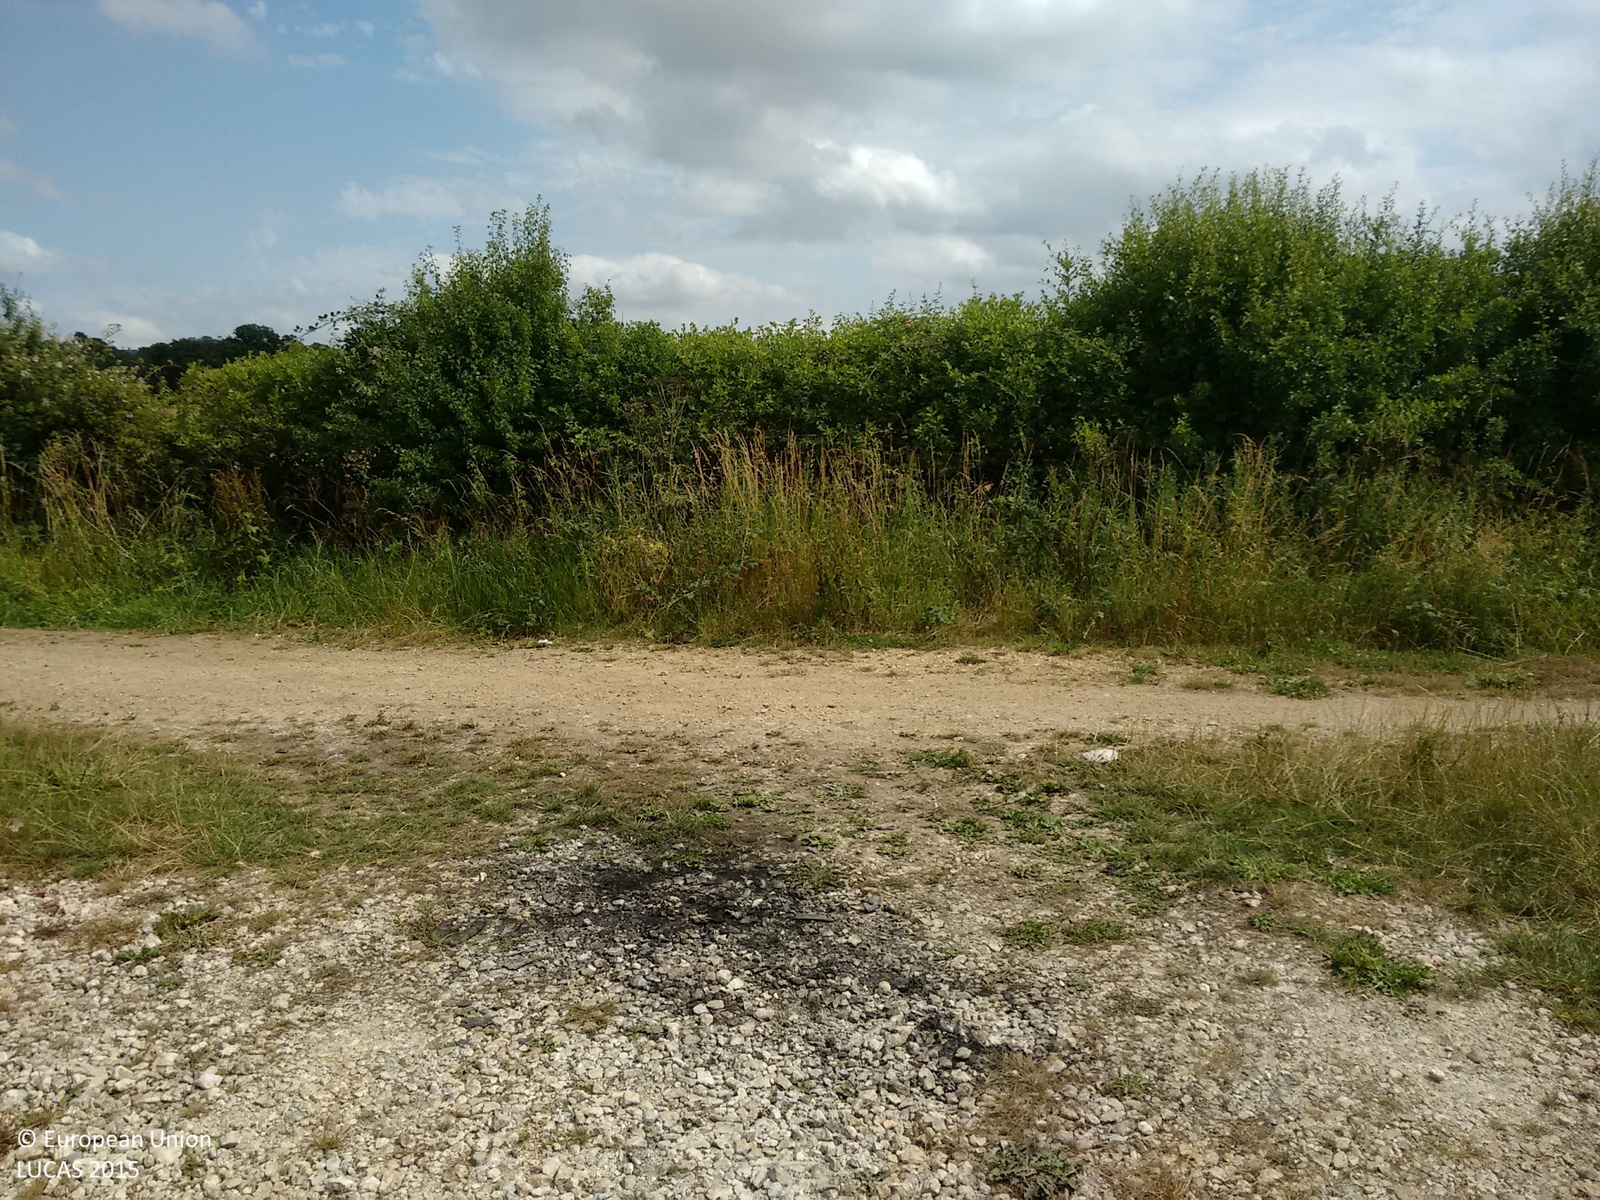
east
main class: Grassland
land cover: Grassland without tree/shrub cover
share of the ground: > 75 %
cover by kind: herbaceous plants 100 %
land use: Agriculture (excluding fallow land and kitchen gardens)
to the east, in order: Grassland without tree/shrub cover; Fences; Broadleaved woodland
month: July
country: GB
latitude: 51.7205
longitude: -1.1786
